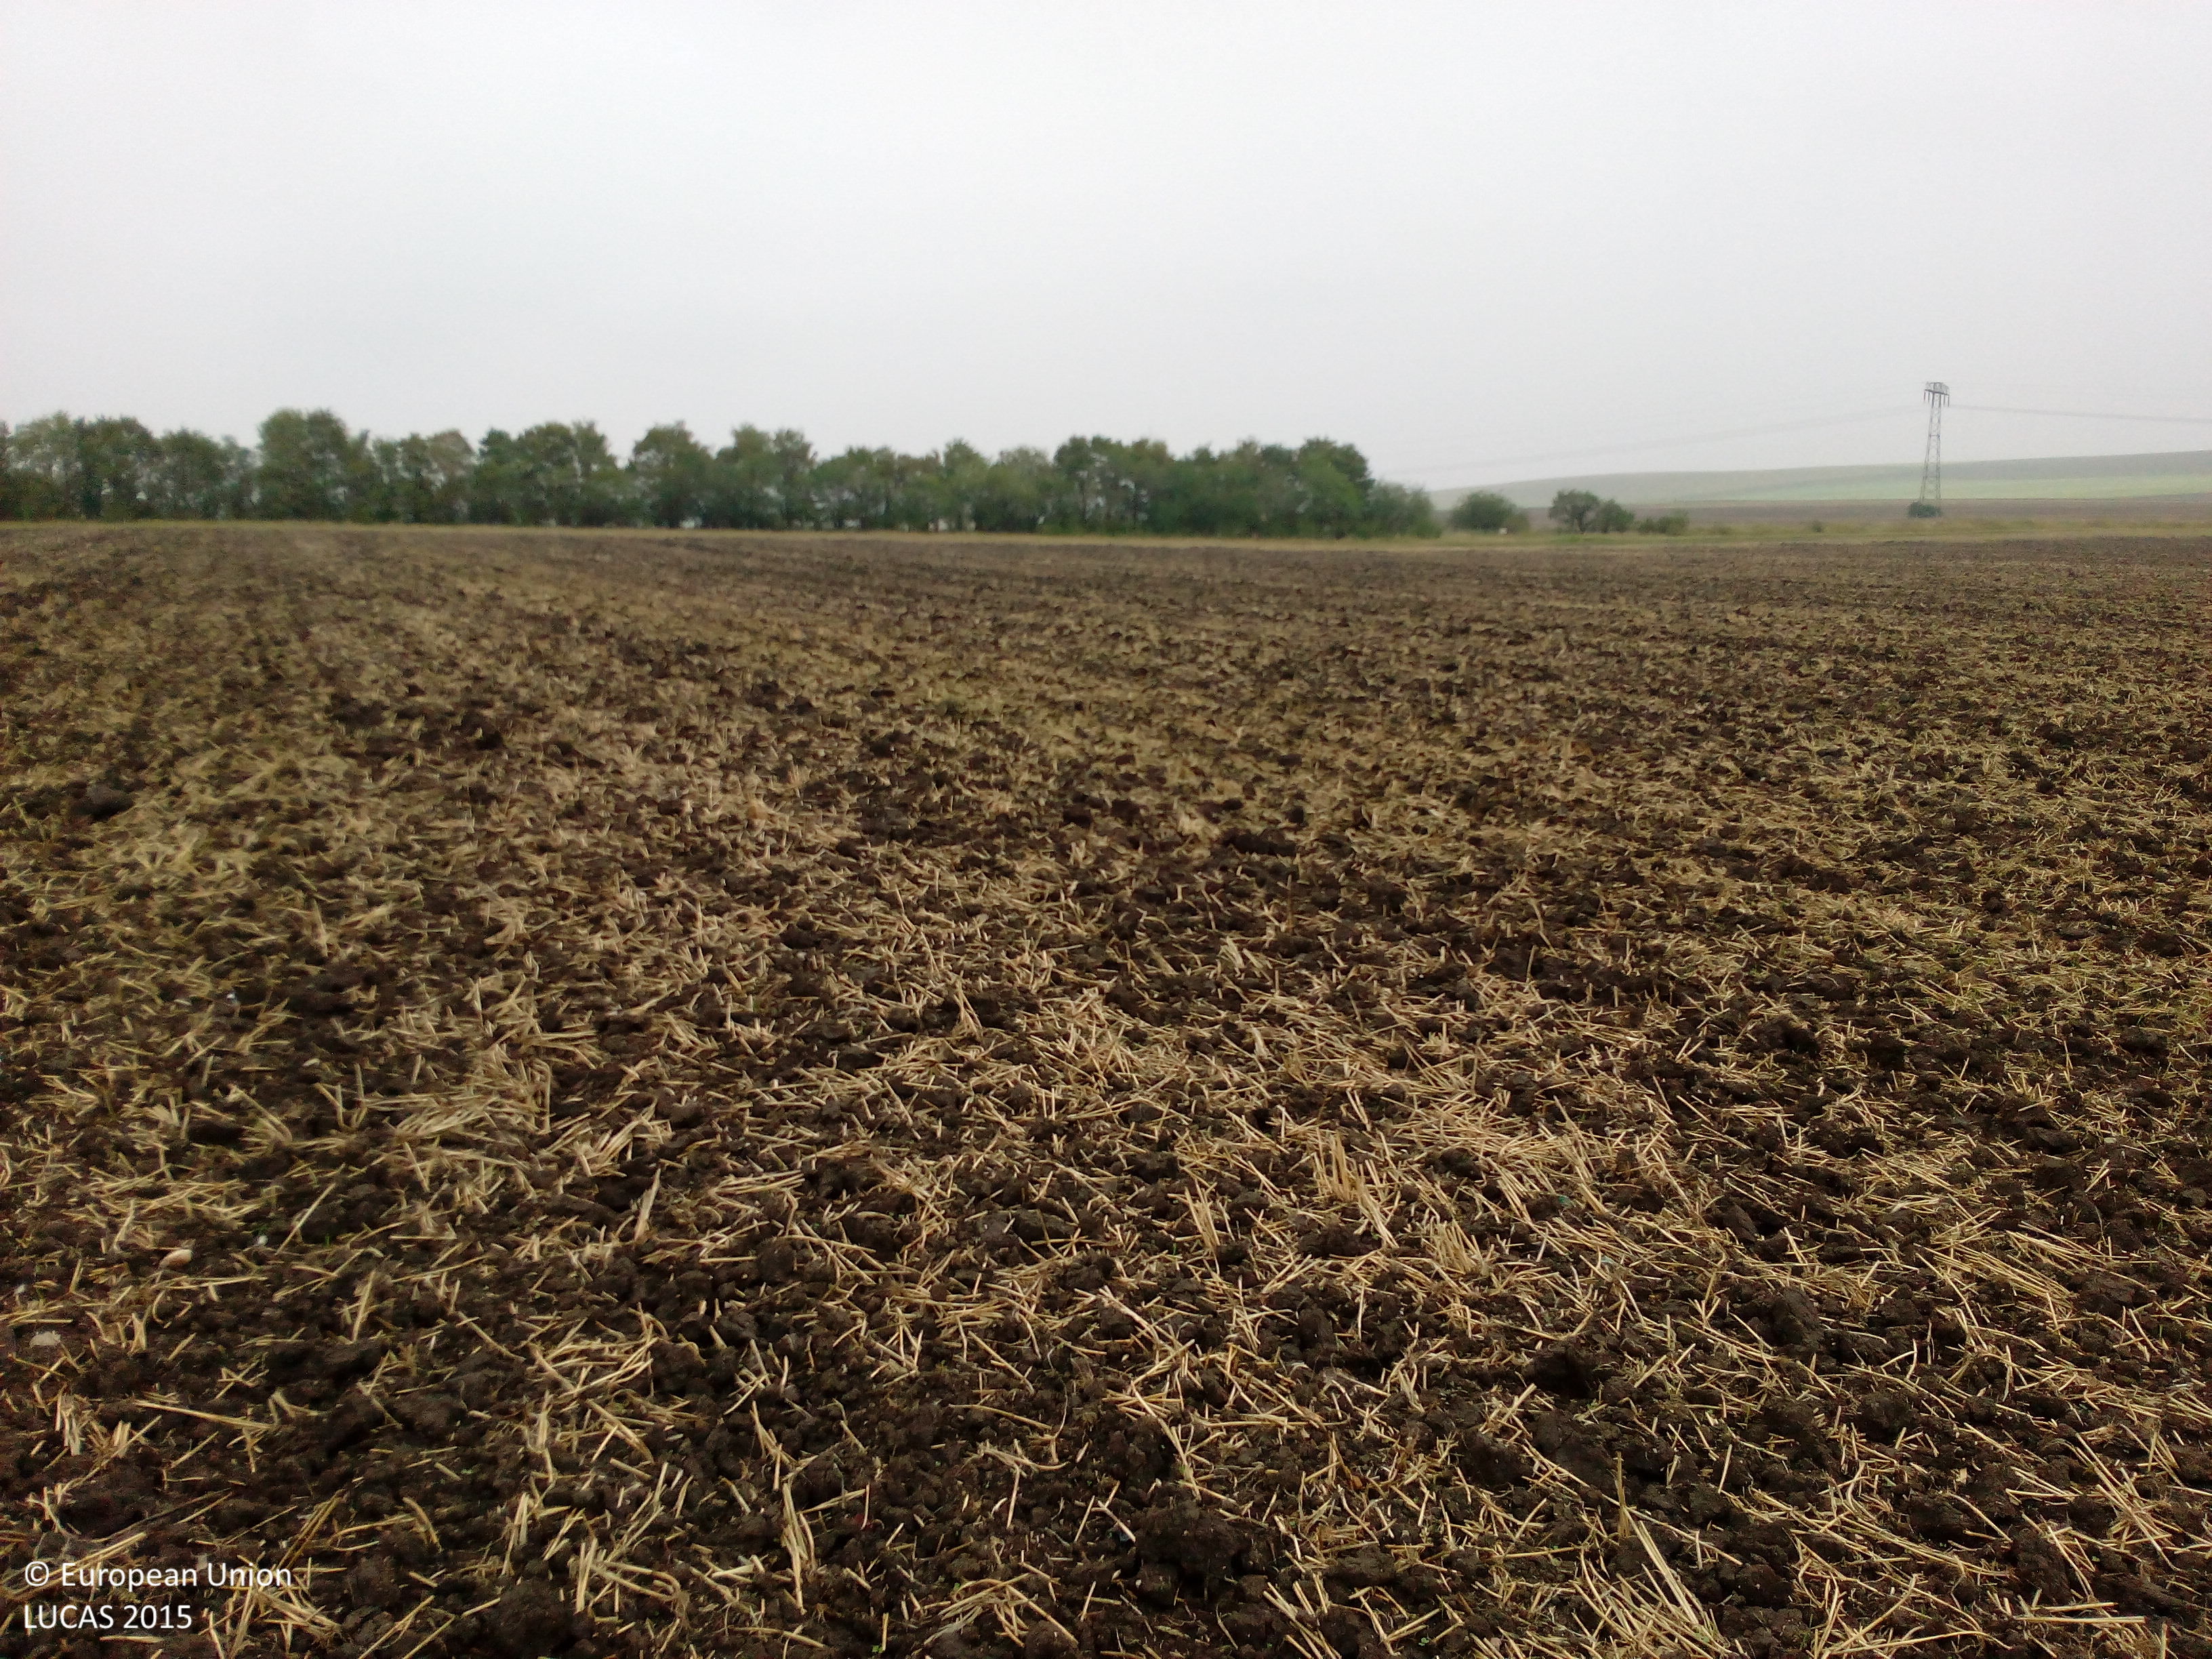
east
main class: Cropland
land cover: Common wheat
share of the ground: < 10 %
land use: Agriculture (excluding fallow land and kitchen gardens)
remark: Harvested field
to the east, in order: Common wheat; Grass margins; Tracks; Grass margins; Ditches and canals; Broadleaved woodland; Common wheat
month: August
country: DE
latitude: 51.0421
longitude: 11.0979
